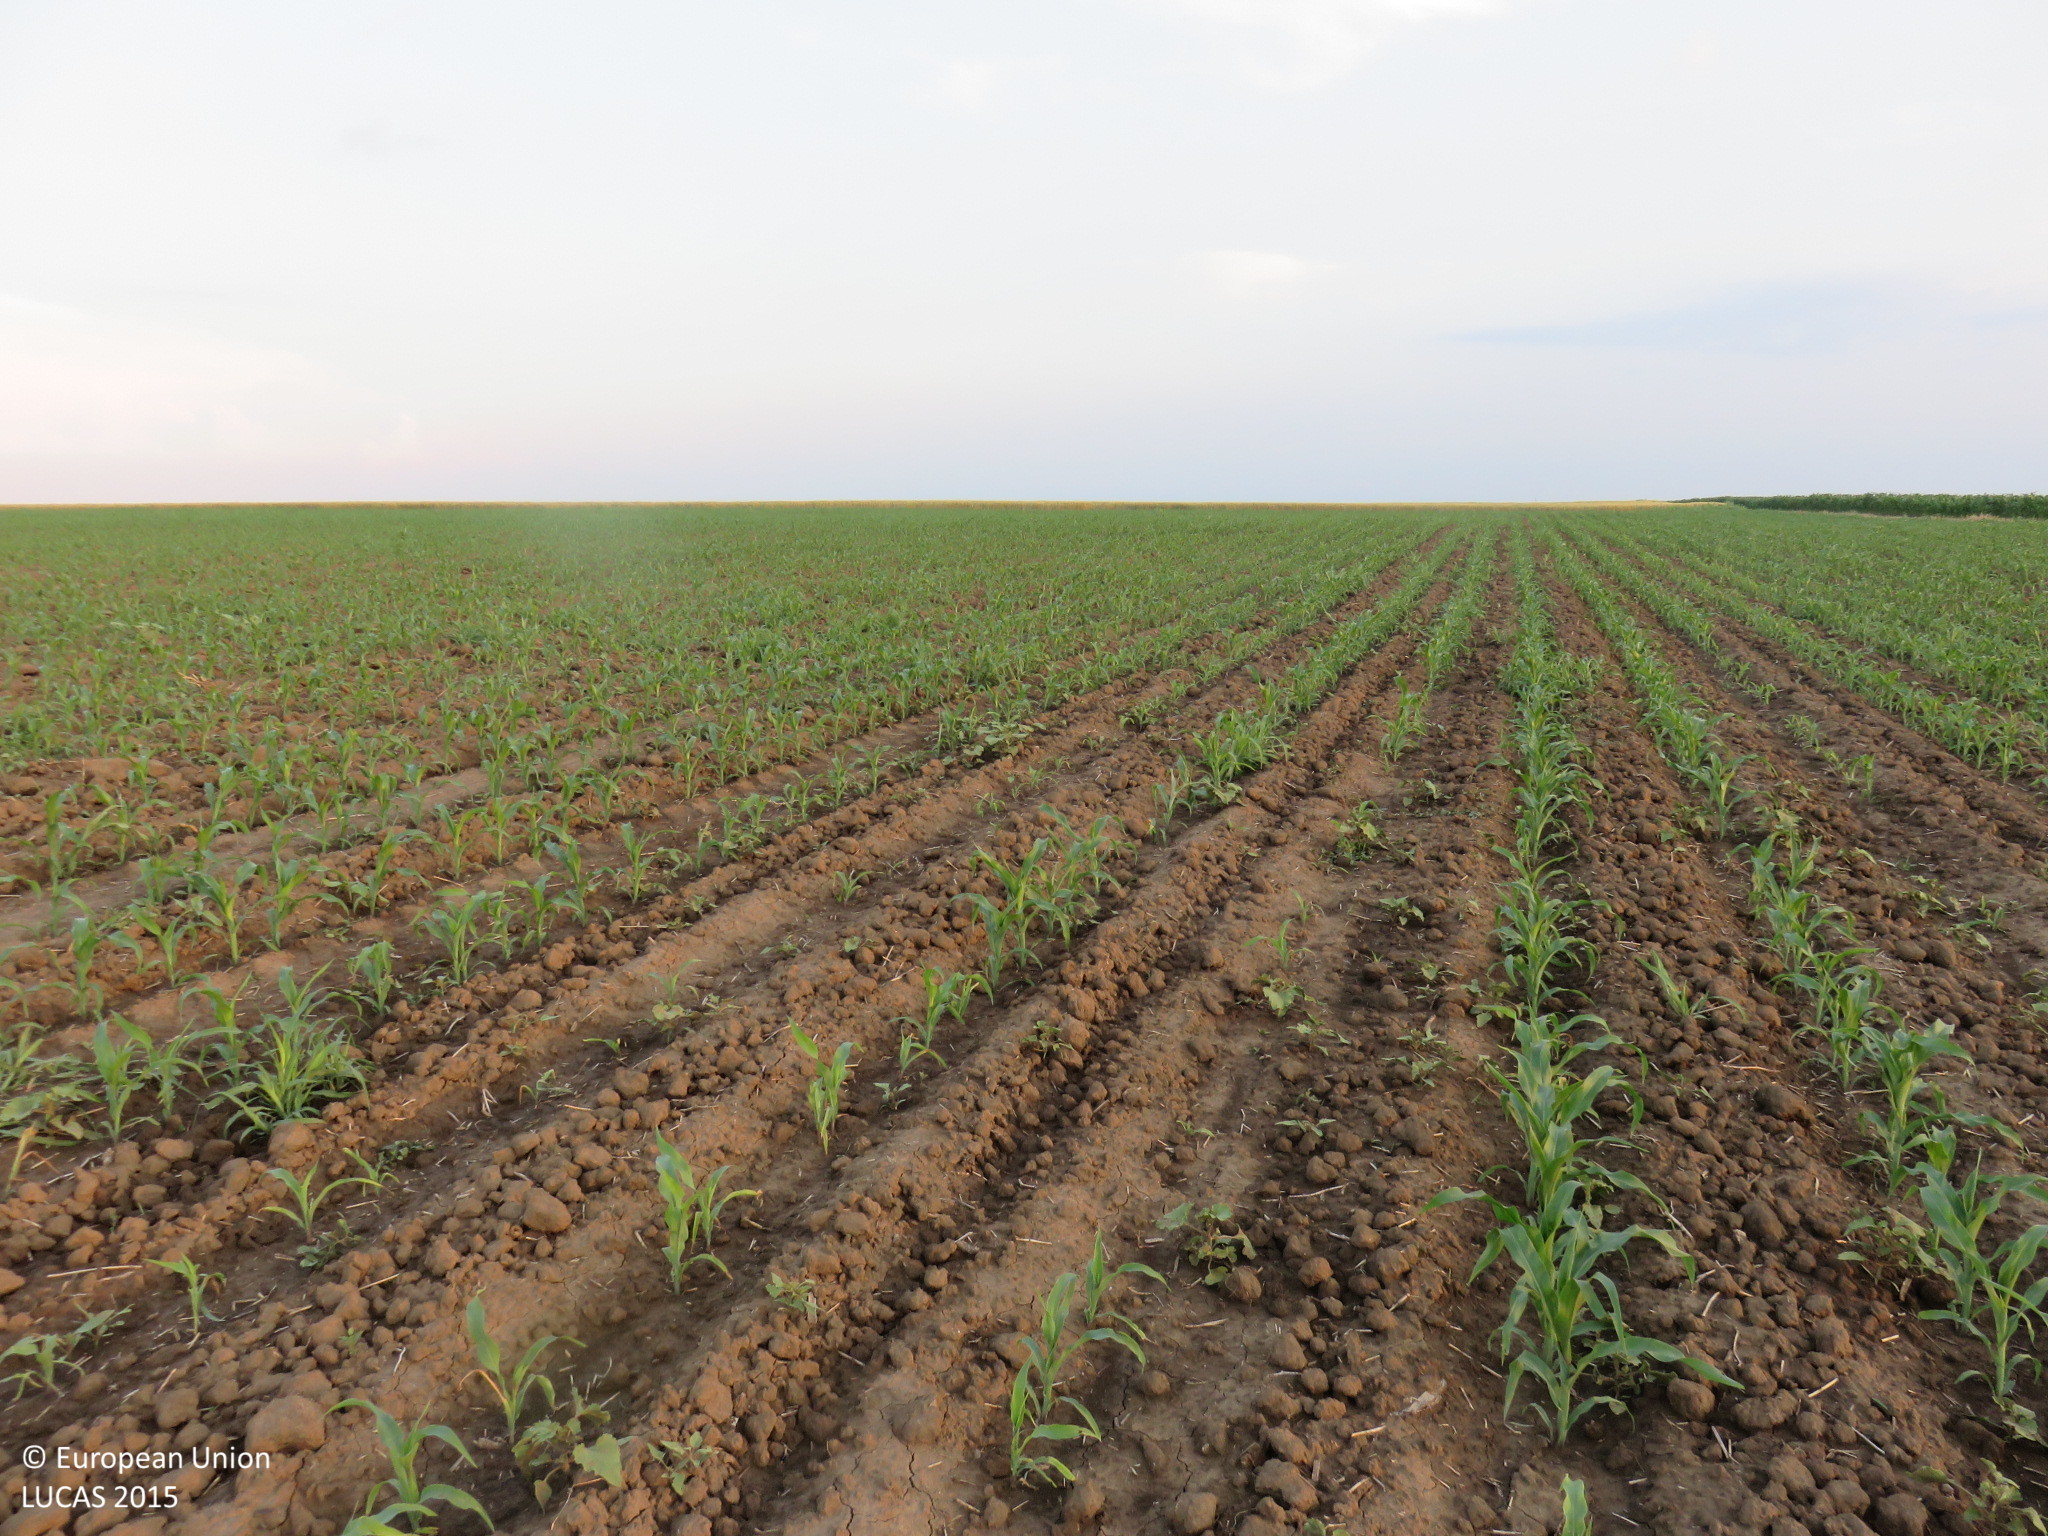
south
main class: Cropland
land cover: Maize
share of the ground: 25 - 50 %
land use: Agriculture (excluding fallow land and kitchen gardens)
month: June
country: BG
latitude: 43.6080
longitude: 24.4460
